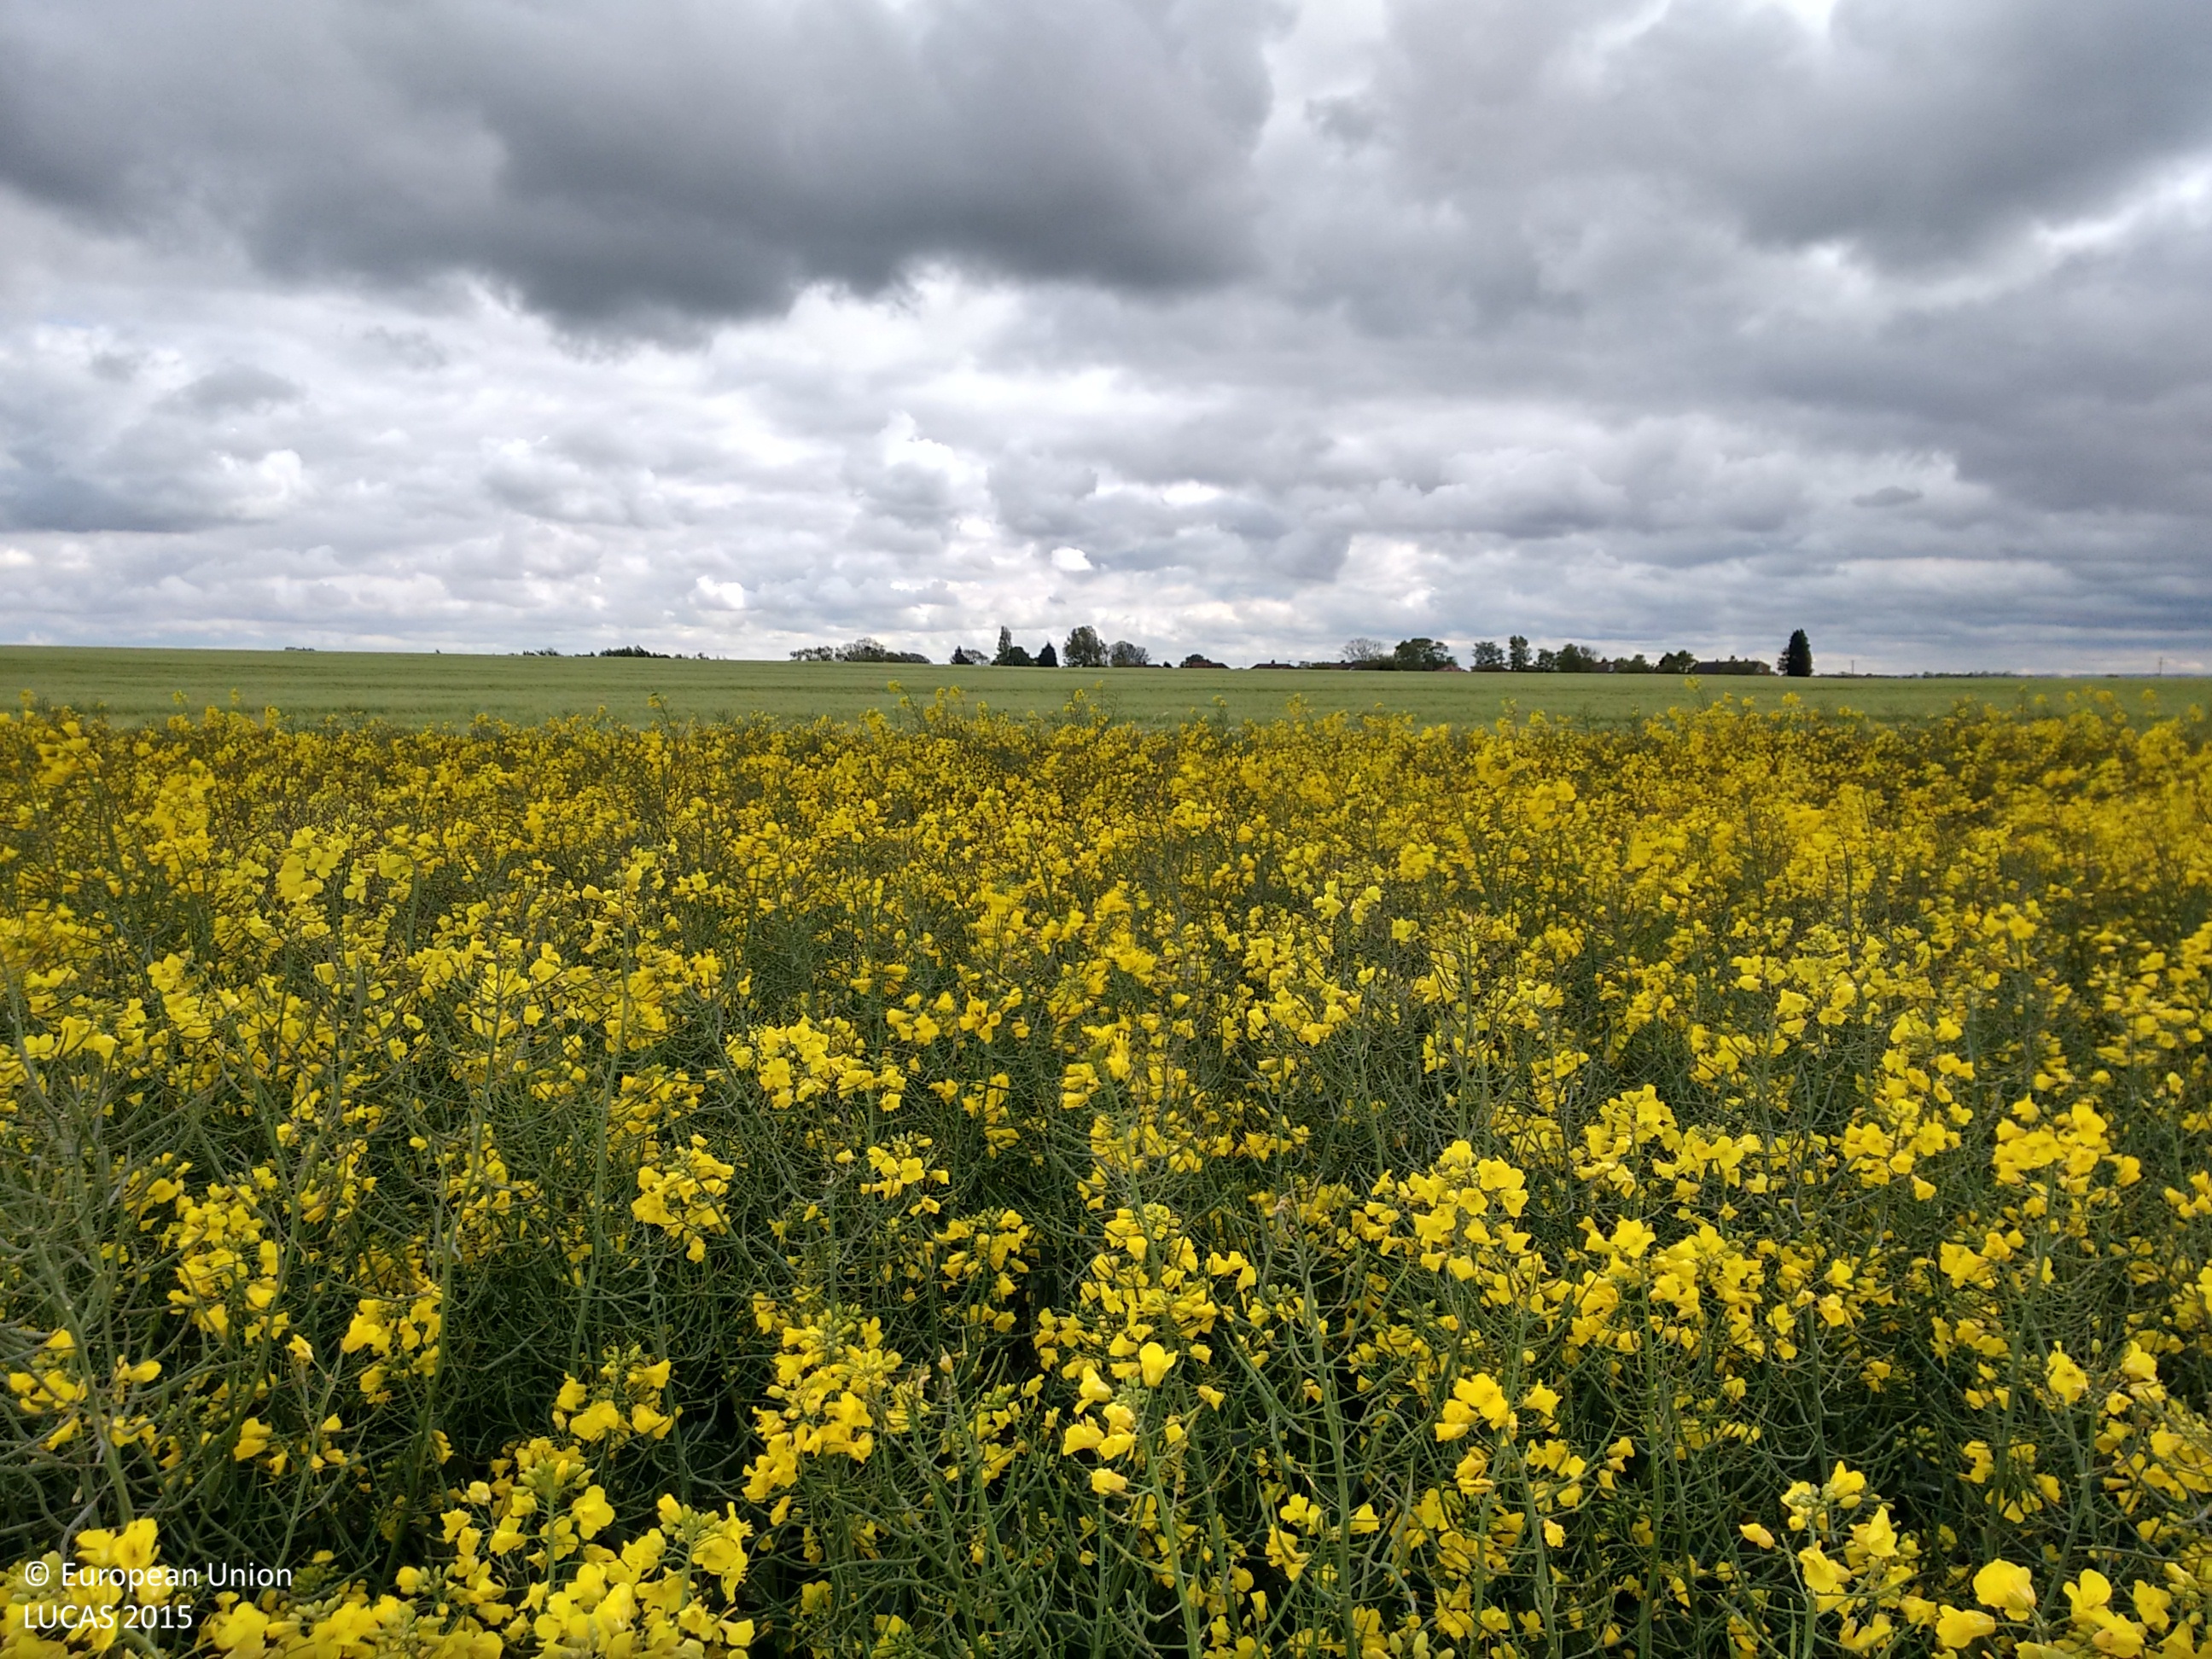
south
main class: Cropland
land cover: Rape and turnip rape
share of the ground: > 75 %
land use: Agriculture (excluding fallow land and kitchen gardens)
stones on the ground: < 10 %
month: May
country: GB
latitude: 53.7183
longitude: -0.1403
